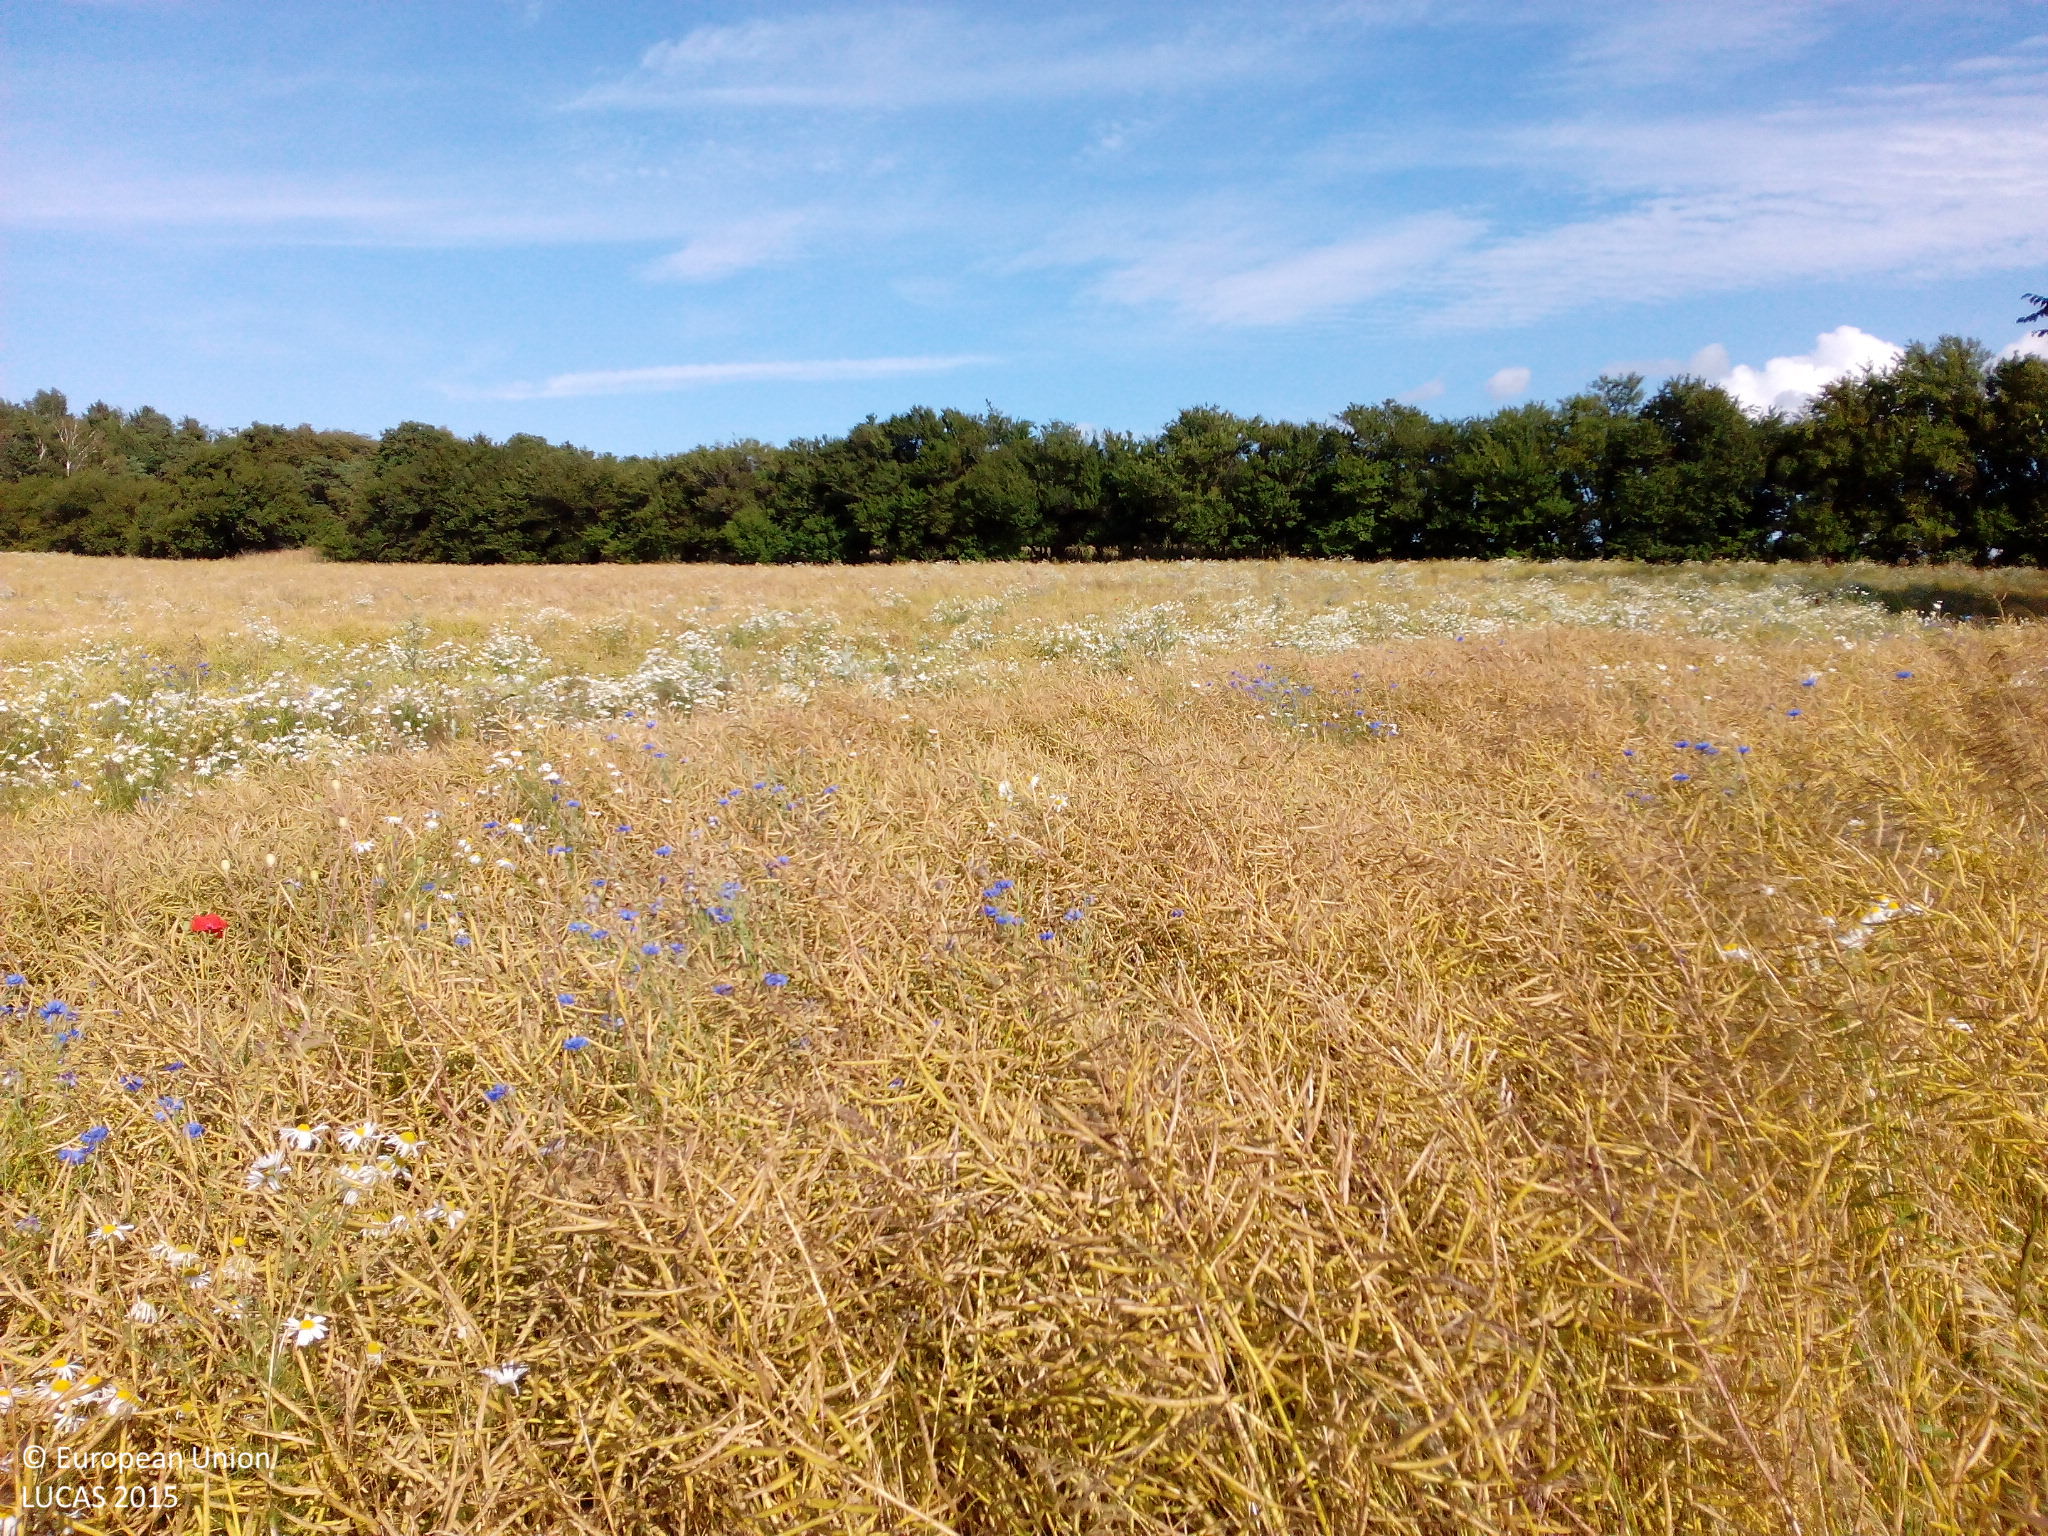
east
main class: Cropland
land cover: Rape and turnip rape
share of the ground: > 75 %
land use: Agriculture (excluding fallow land and kitchen gardens)
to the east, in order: Rape and turnip rape; Broadleaved woodland; Rye; Spruce dominated coniferous woodland; Broadleaved woodland
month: July
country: DK
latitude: 55.9749
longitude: 11.9691
